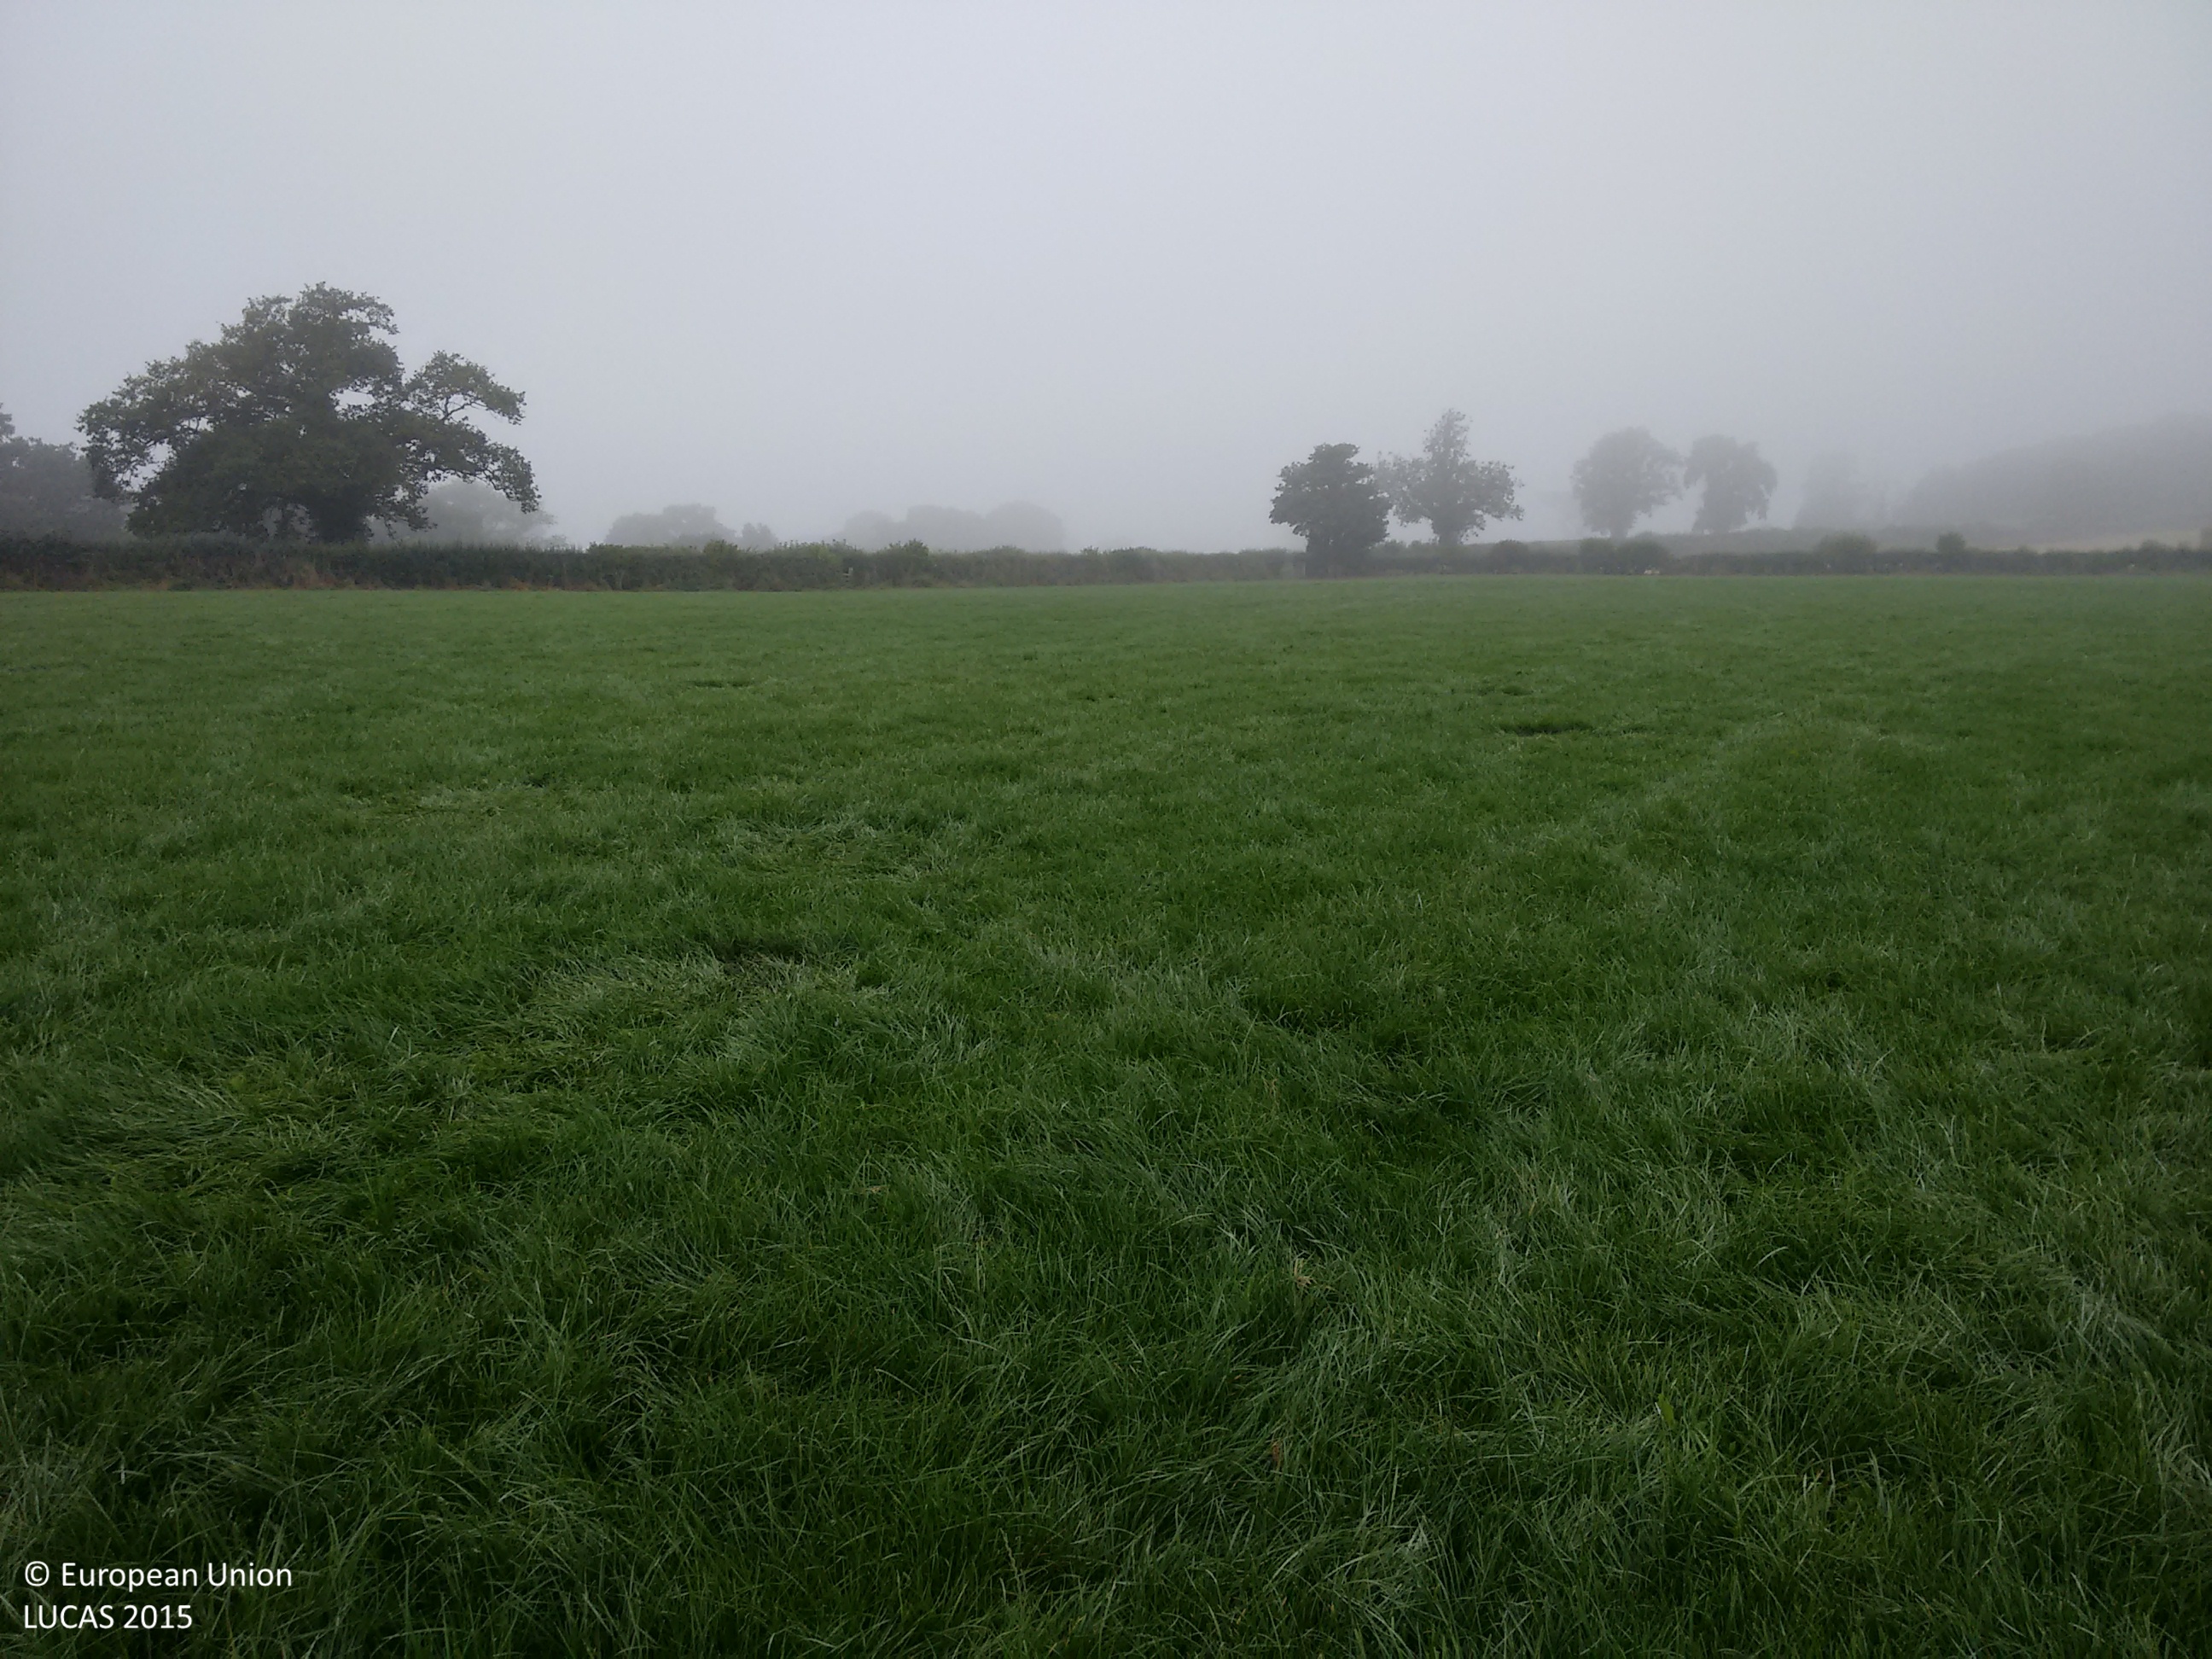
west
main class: Grassland
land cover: Grassland without tree/shrub cover
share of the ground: > 75 %
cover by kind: herbaceous plants 100 %
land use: Agriculture (excluding fallow land and kitchen gardens)
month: September
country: GB
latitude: 52.7895
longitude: -2.9903
